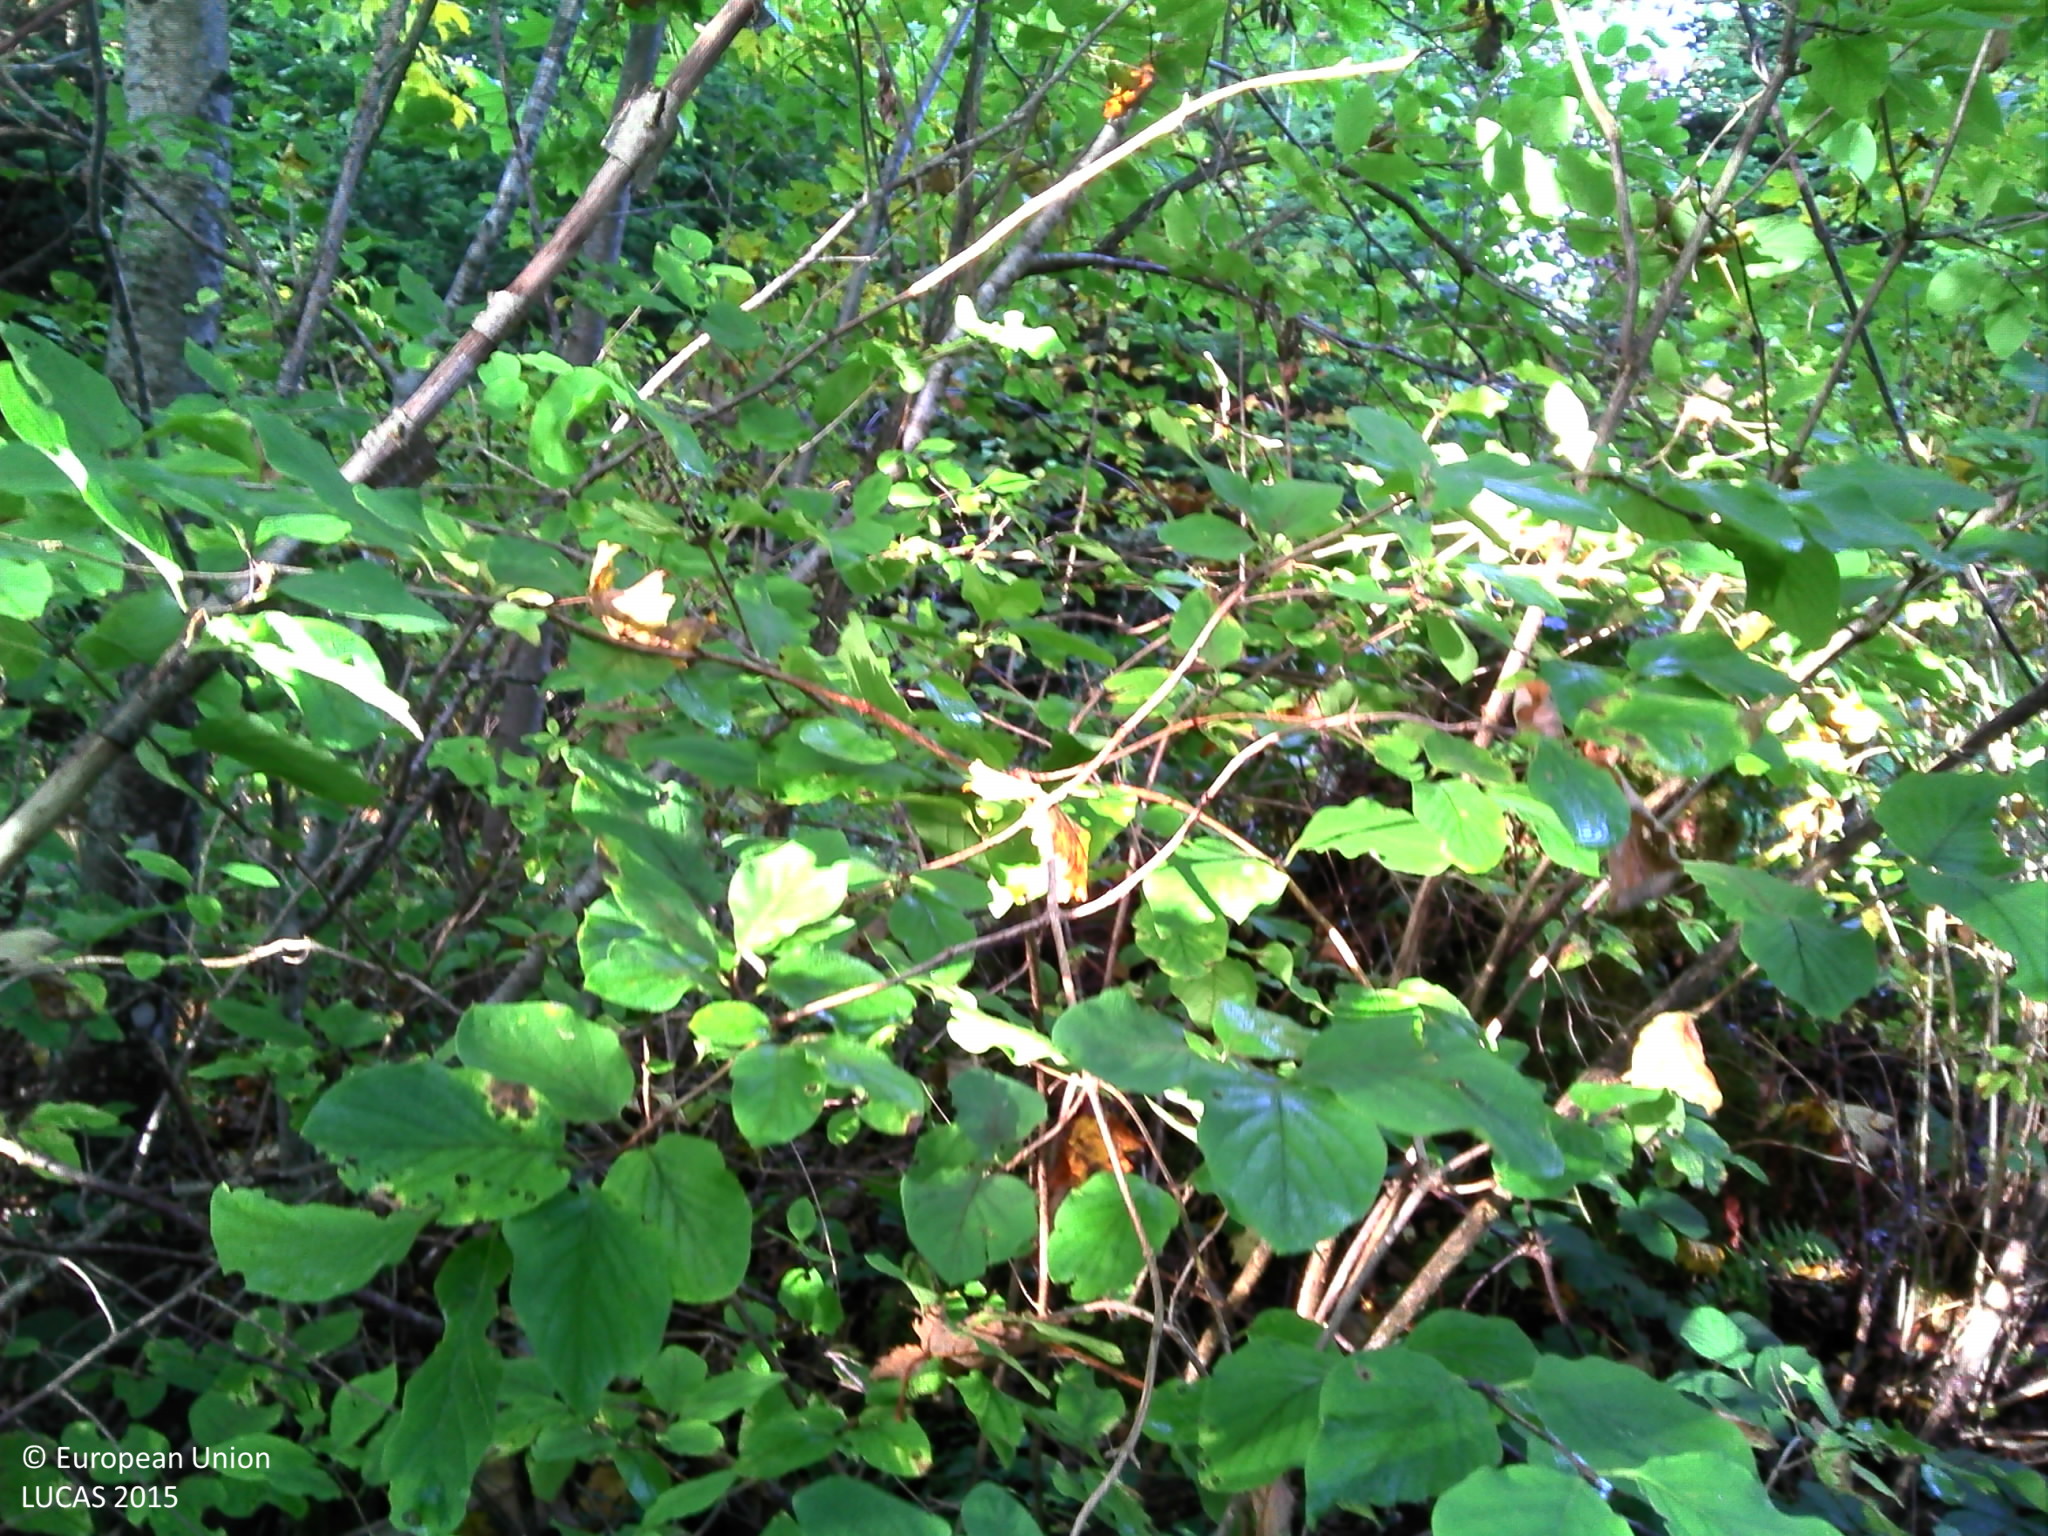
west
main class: Woodland
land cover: Spruce dominated mixed woodland
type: hemiboreal forest and nemoral coniferous forest and mixed broadleaved-coniferous forest
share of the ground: 50 - 75 %
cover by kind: coniferous forest trees 40 %, broadleaved forest trees 30 %, shrubs 20 %, herbaceous plants 10 %
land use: Forestry
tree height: > 5 m
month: October
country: FR
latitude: 47.0813
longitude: 6.3274
